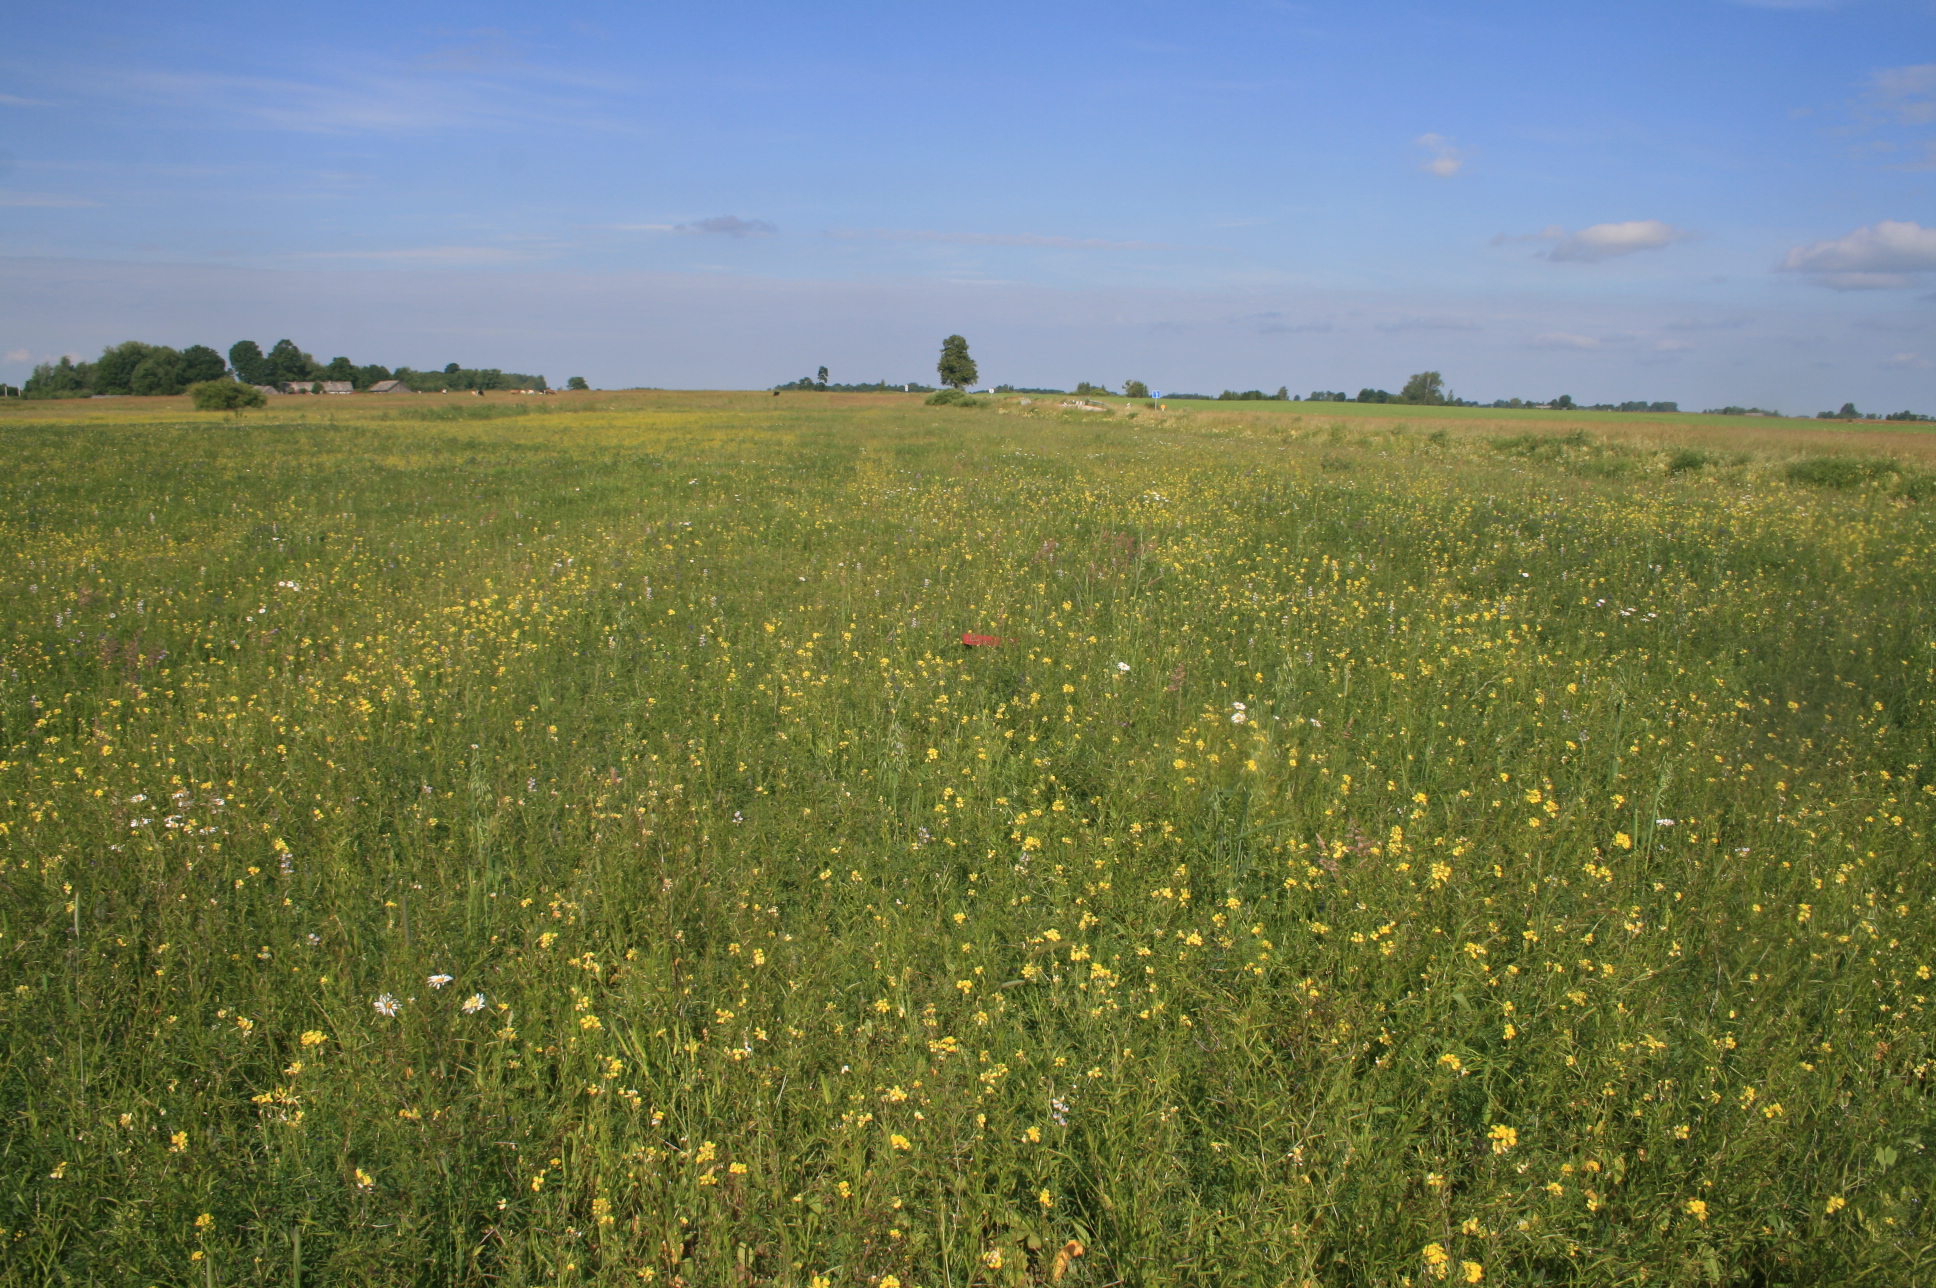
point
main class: Cropland
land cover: Dry pulses
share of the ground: > 75 %
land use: Agriculture (excluding fallow land and kitchen gardens)
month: June
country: LT
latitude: 55.2851
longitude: 21.7166
